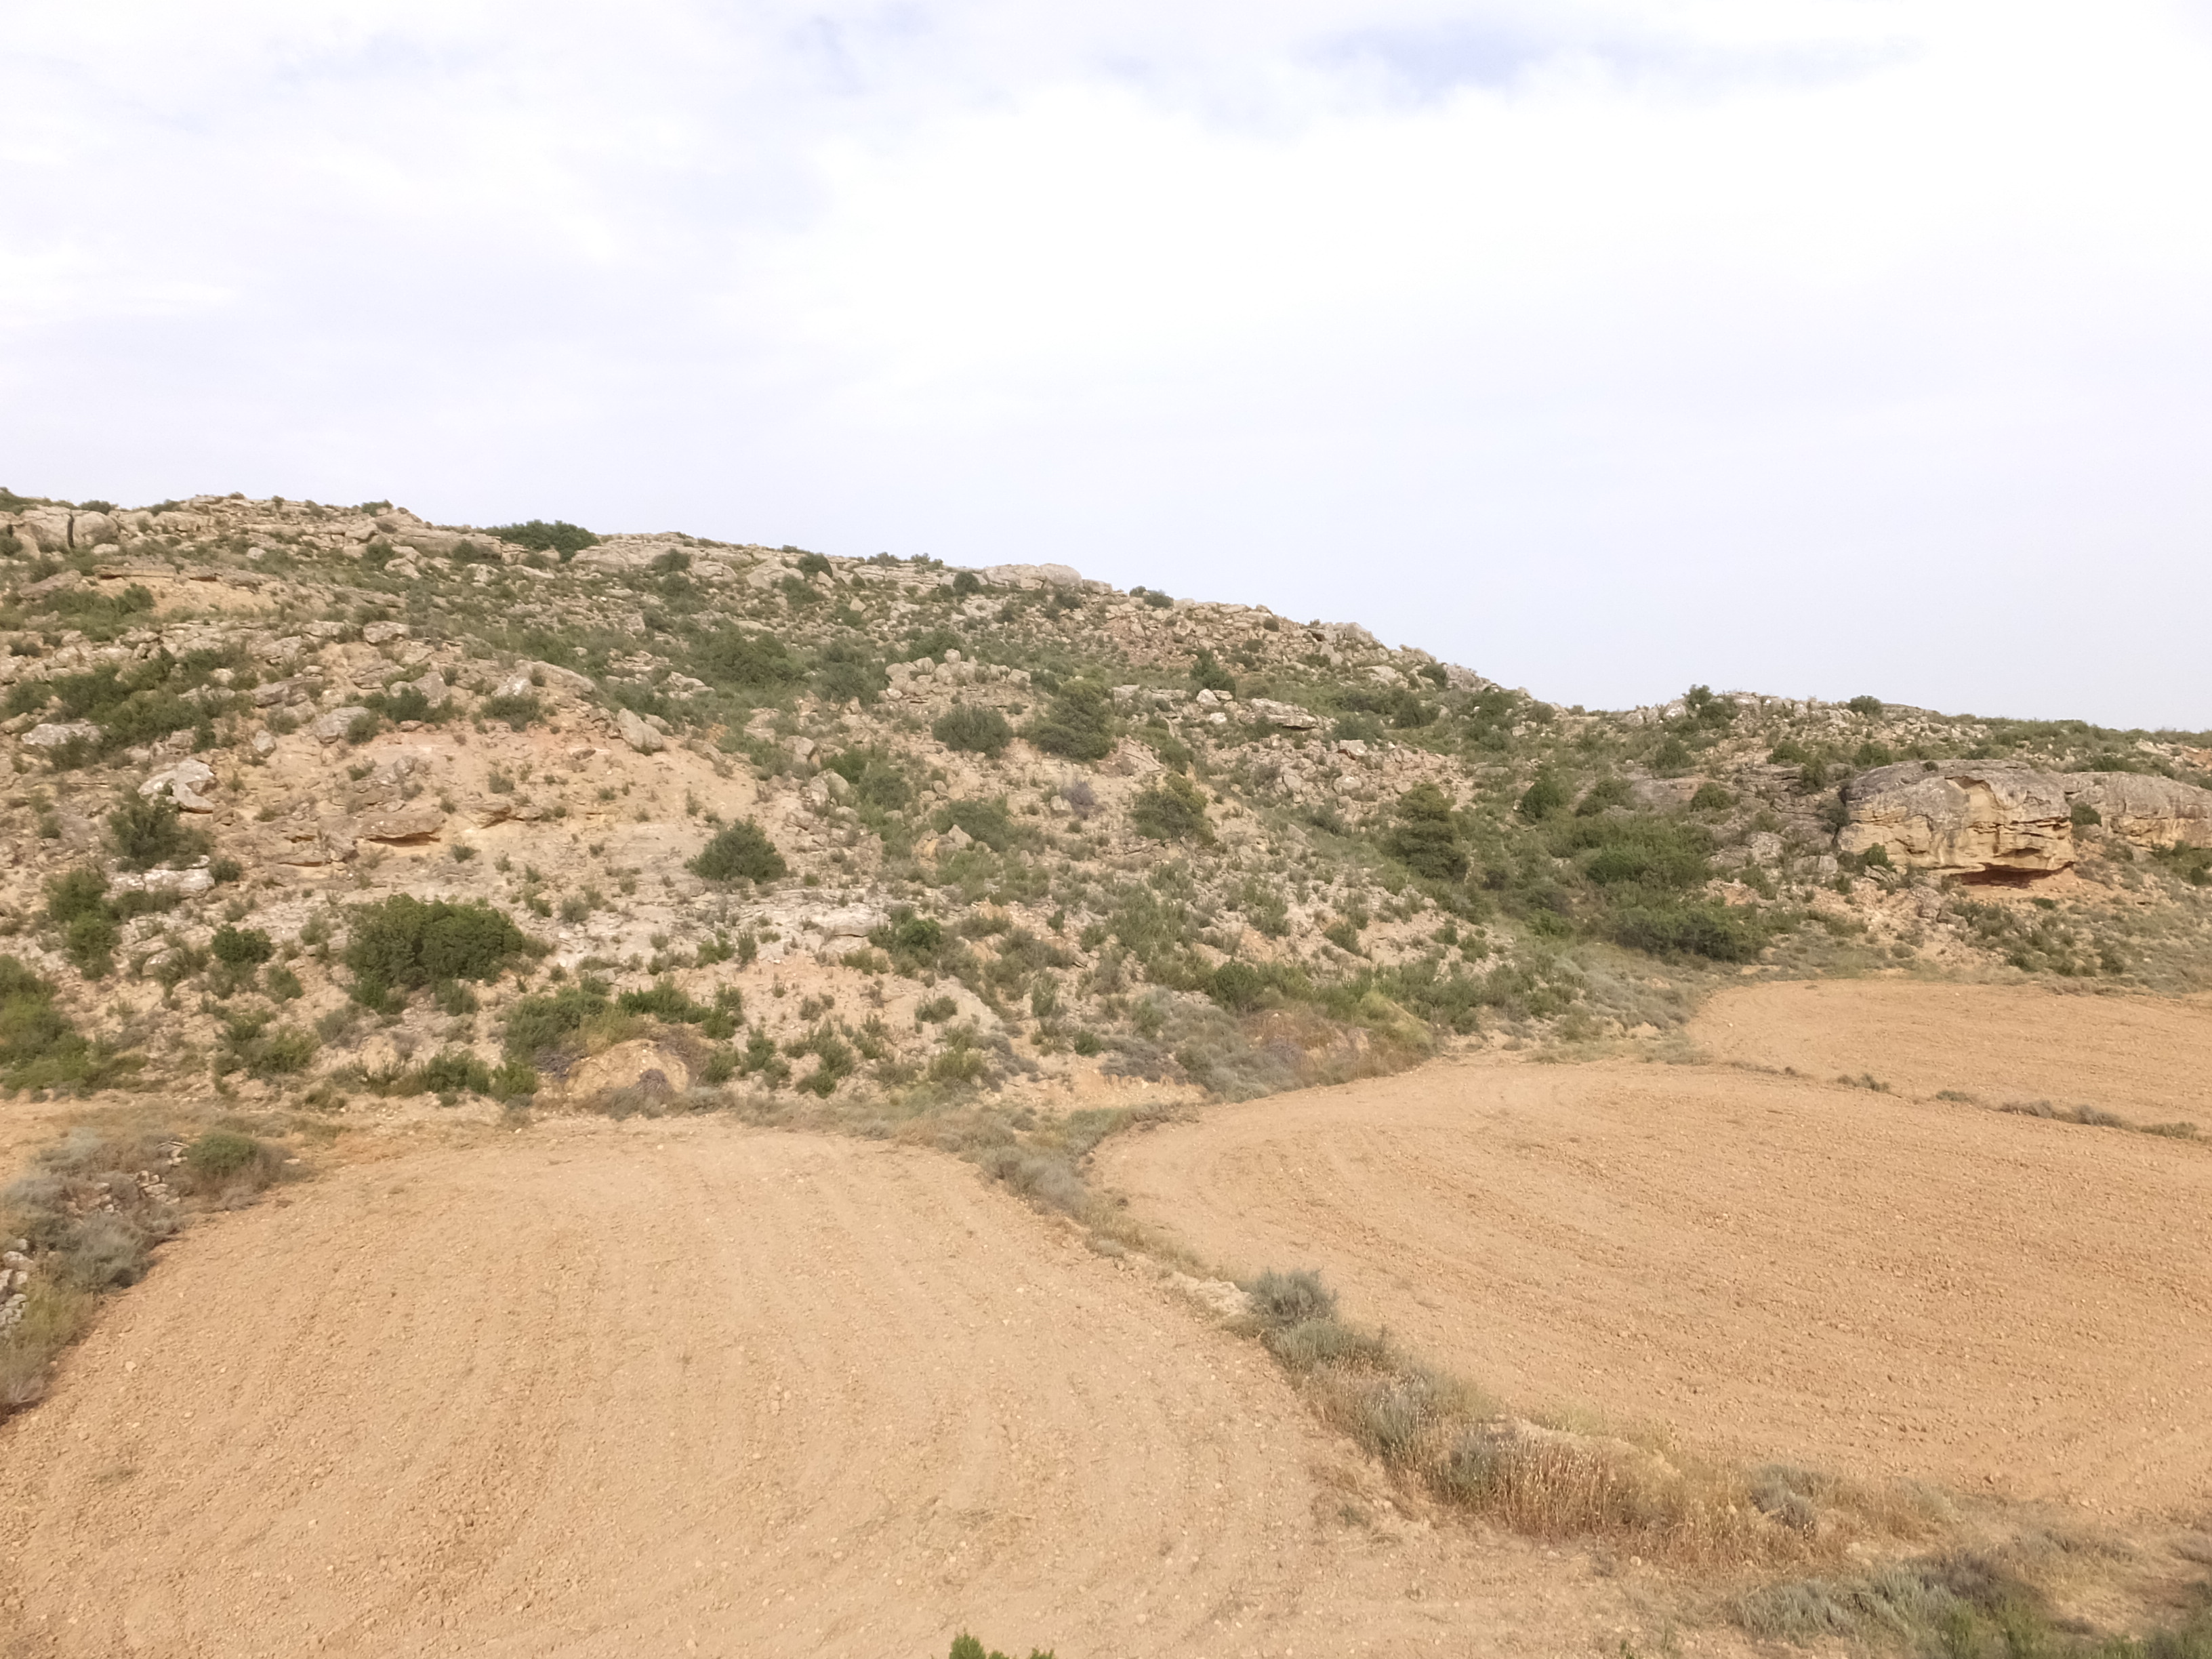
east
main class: Shrubland
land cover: Shrubland with sparse tree cover
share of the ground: > 75 %
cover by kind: shrubs 75 %, herbaceous plants 20 %, coniferous forest trees 5 %
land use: Semi-natural and natural areas not in use
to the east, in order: Shrubland with sparse tree cover; Grassland with sparse tree/shrub cover; Shrubland with sparse tree cover; Rock outcrops; Shrubland with sparse tree cover
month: May
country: ES
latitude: 41.3136
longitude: -0.2515
